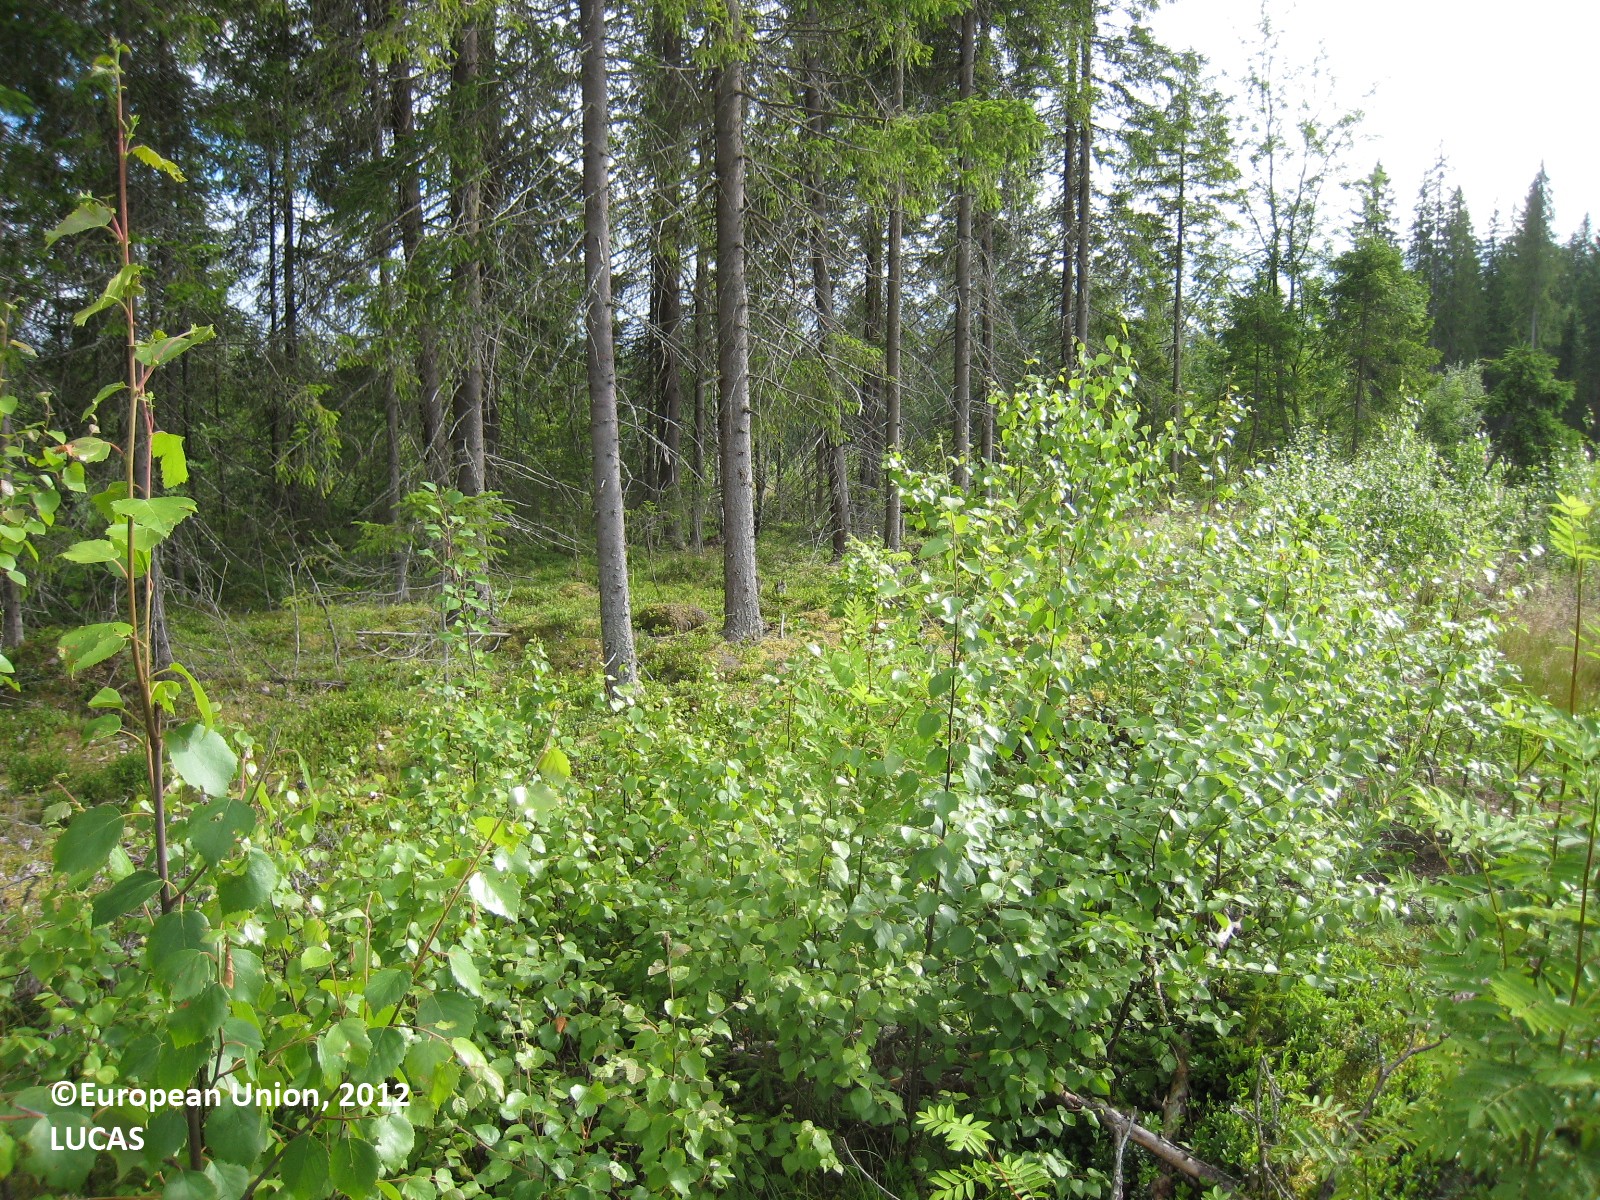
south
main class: Woodland
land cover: Spruce dominated mixed woodland
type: boreal forest
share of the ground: 10 - 25 %
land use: Forestry
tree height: < 5 m
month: July
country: FI
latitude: 61.7937
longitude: 27.3725
